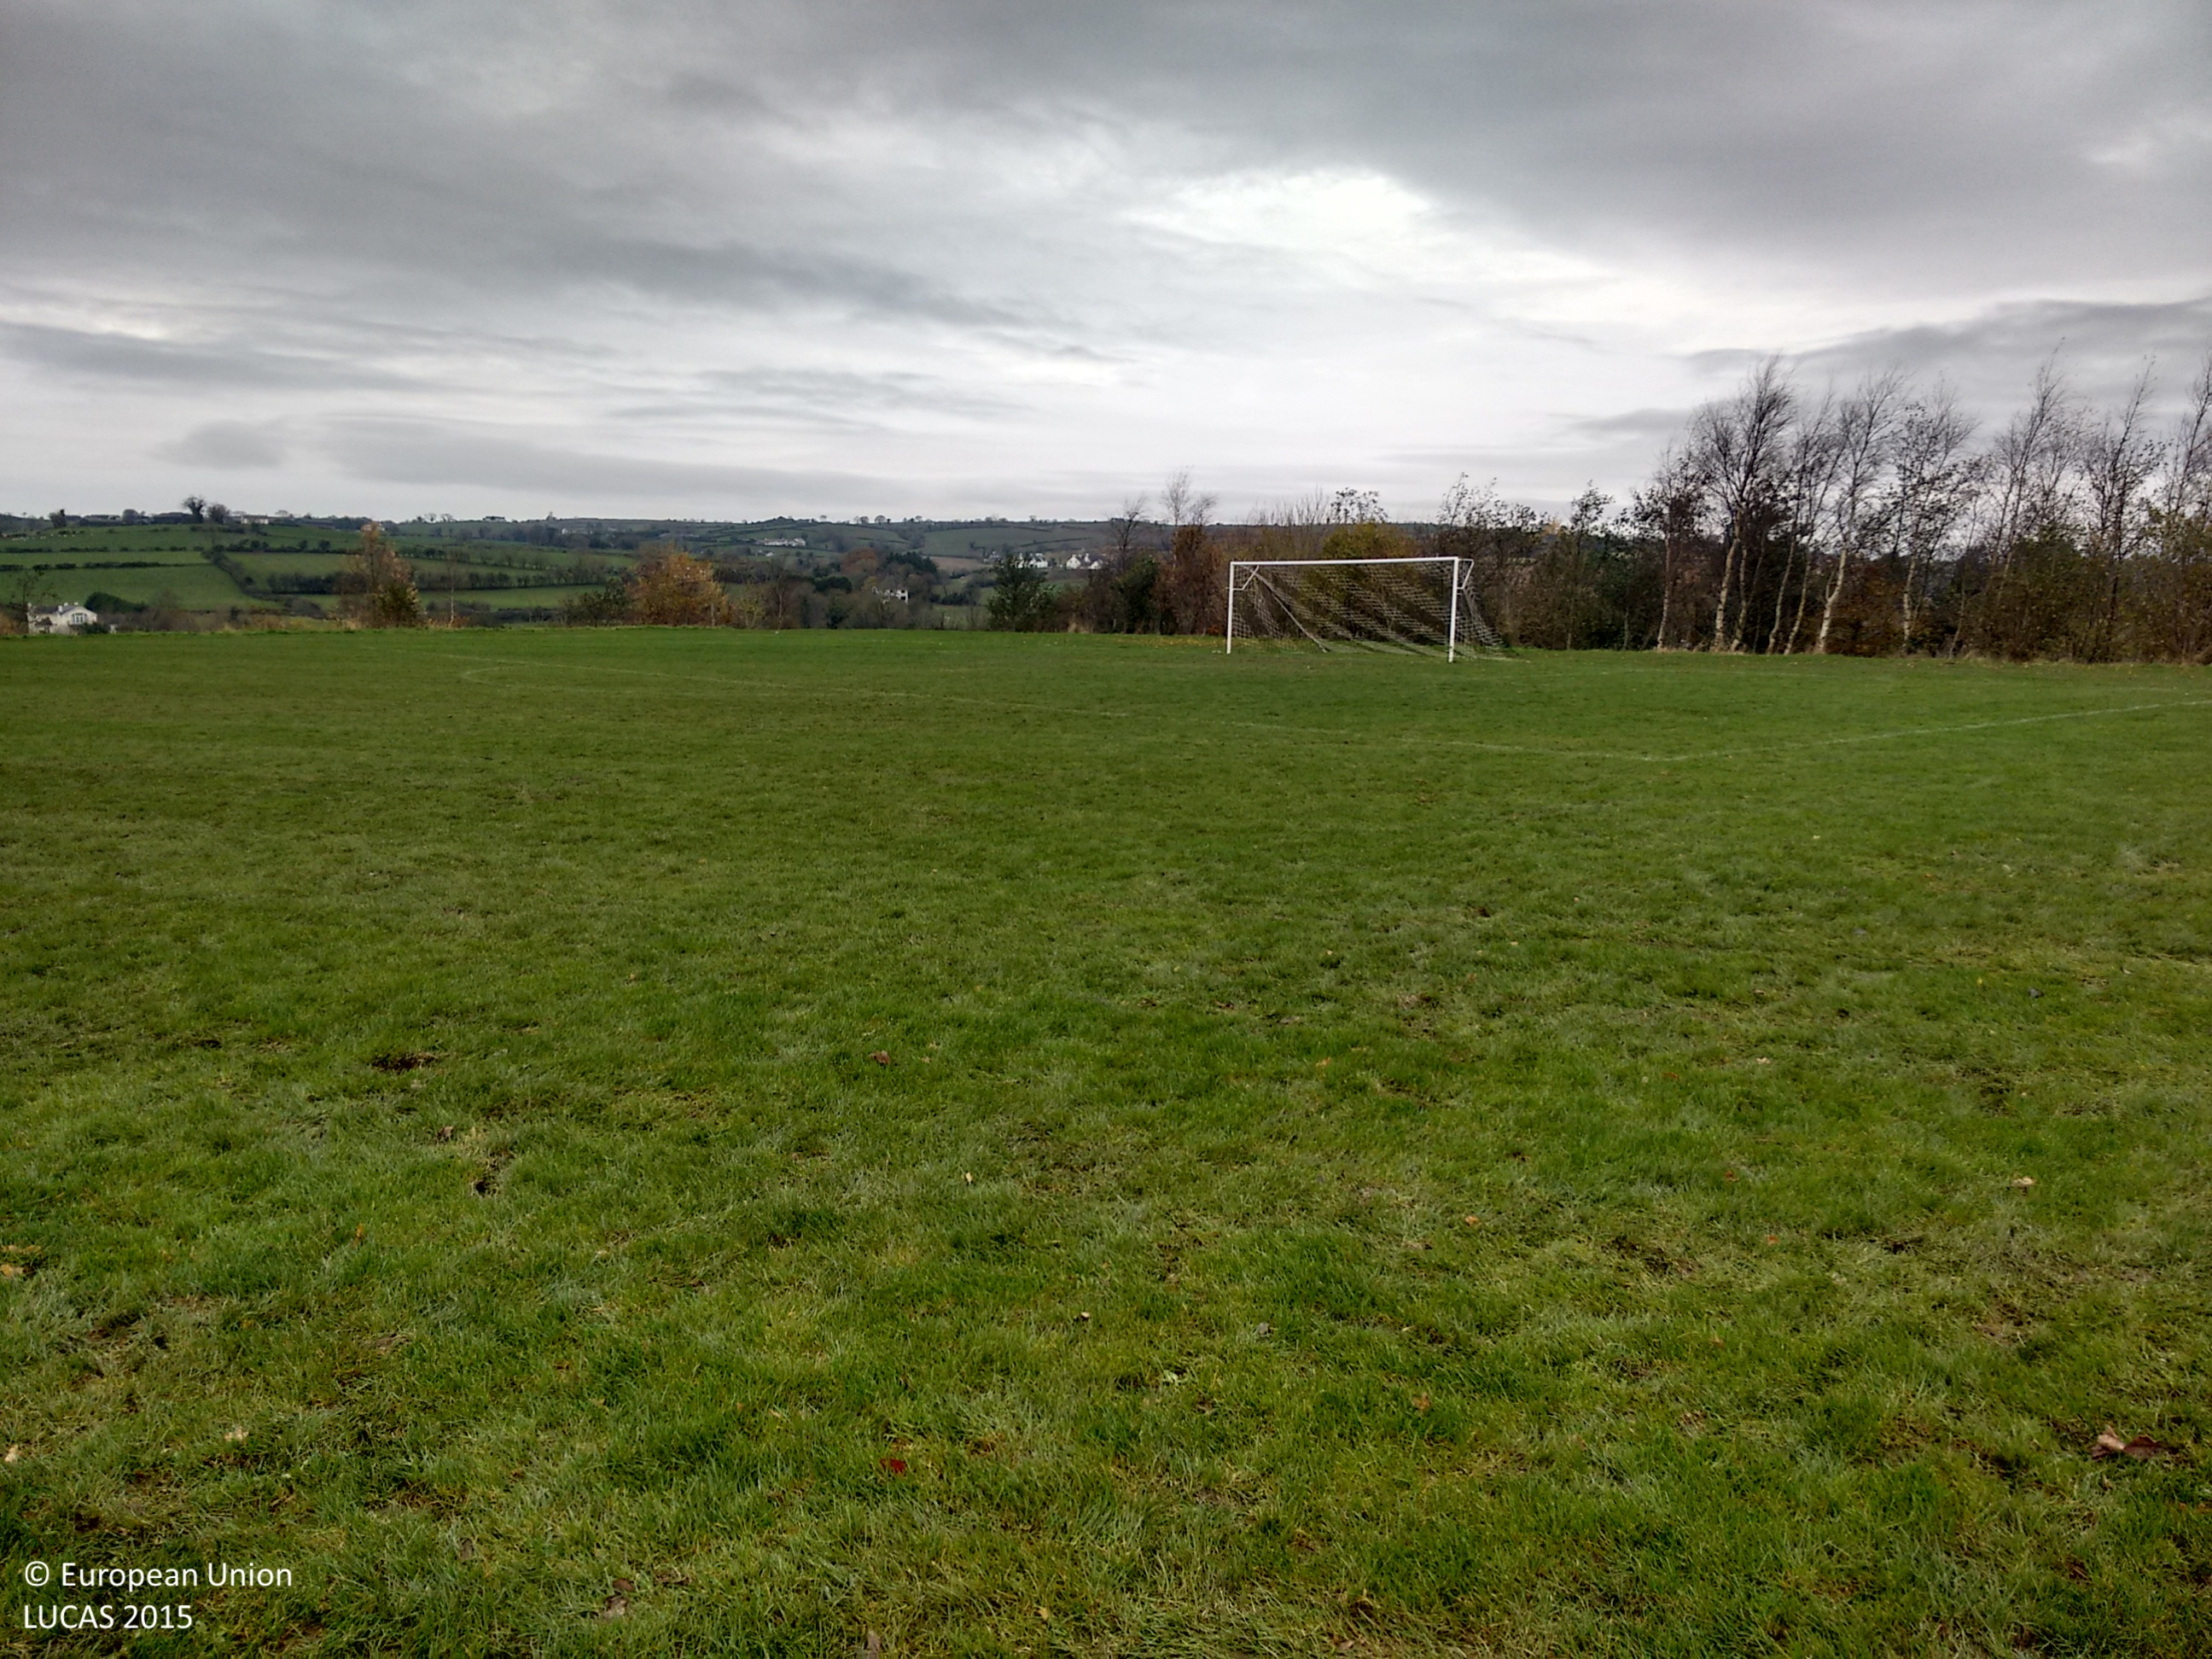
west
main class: Grassland
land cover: Grassland without tree/shrub cover
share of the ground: > 75 %
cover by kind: herbaceous plants 100 %
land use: Sport
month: November
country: GB
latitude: 54.5785
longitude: -5.7758
